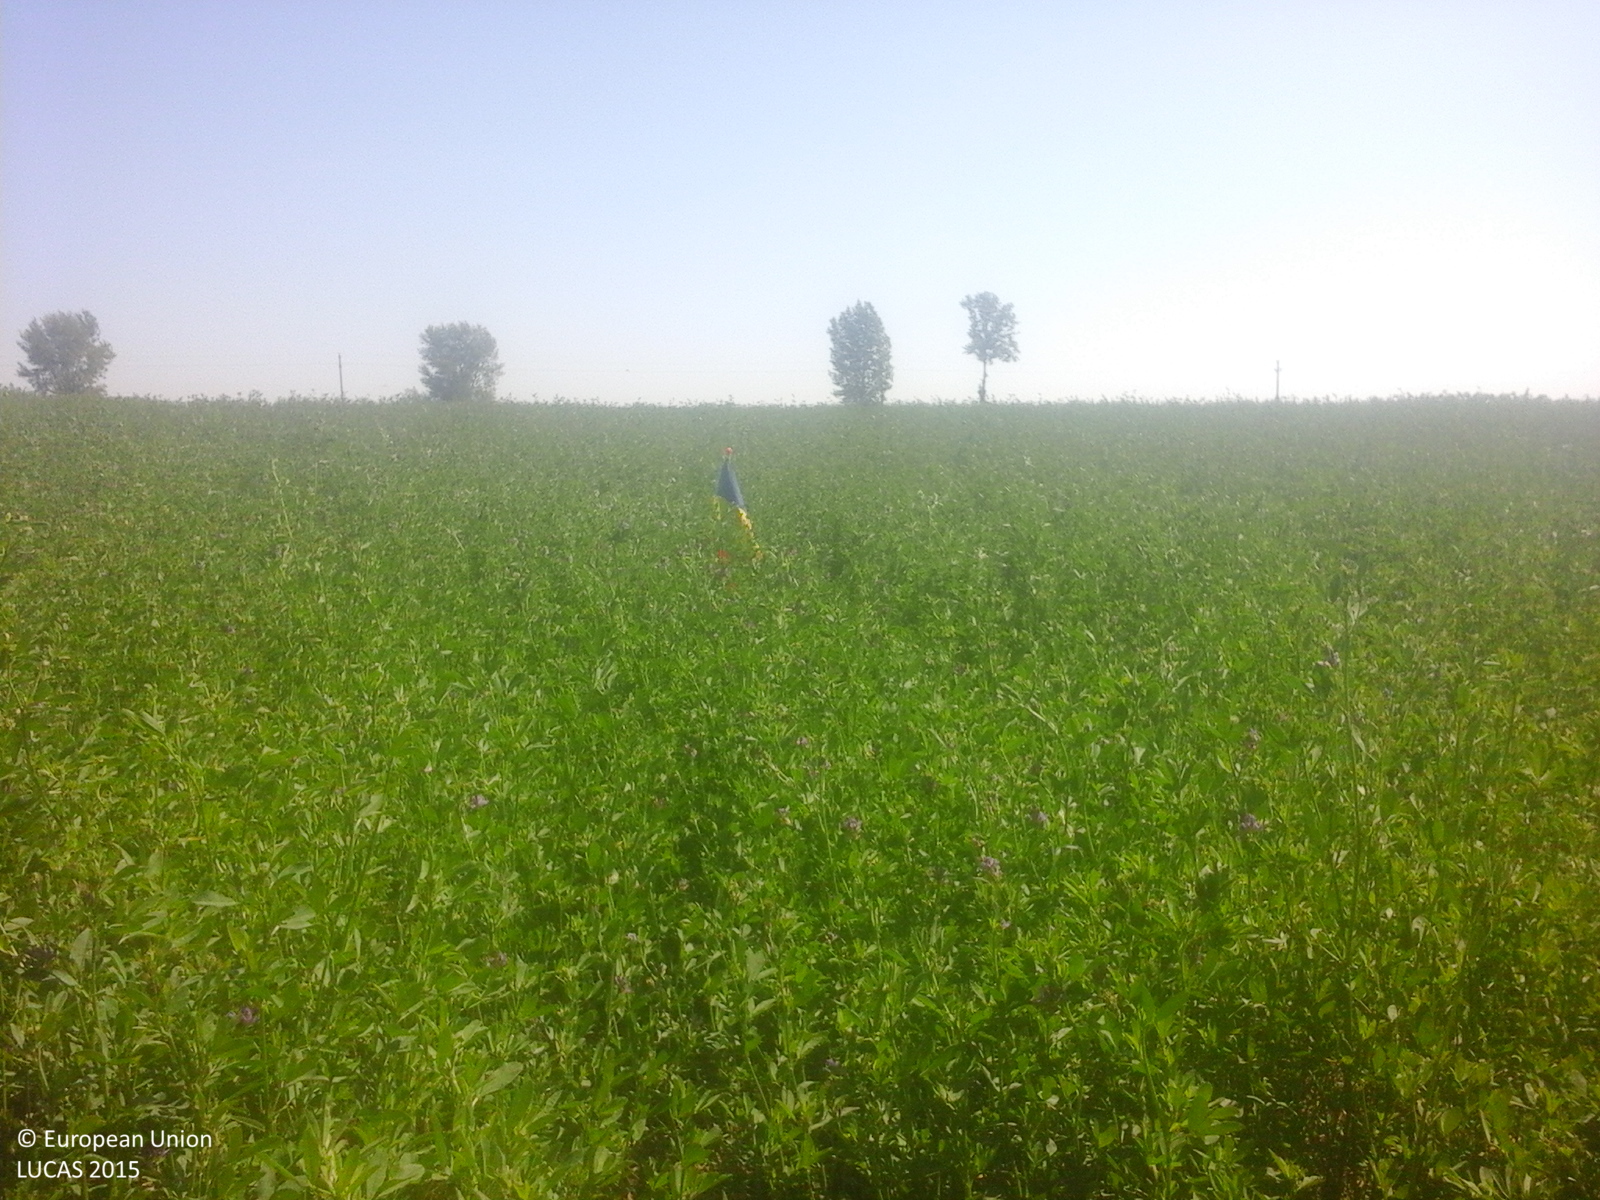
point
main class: Cropland
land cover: Lucerne
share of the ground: > 75 %
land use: Agriculture (excluding fallow land and kitchen gardens)
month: June
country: RO
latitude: 47.8282
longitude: 27.1140
